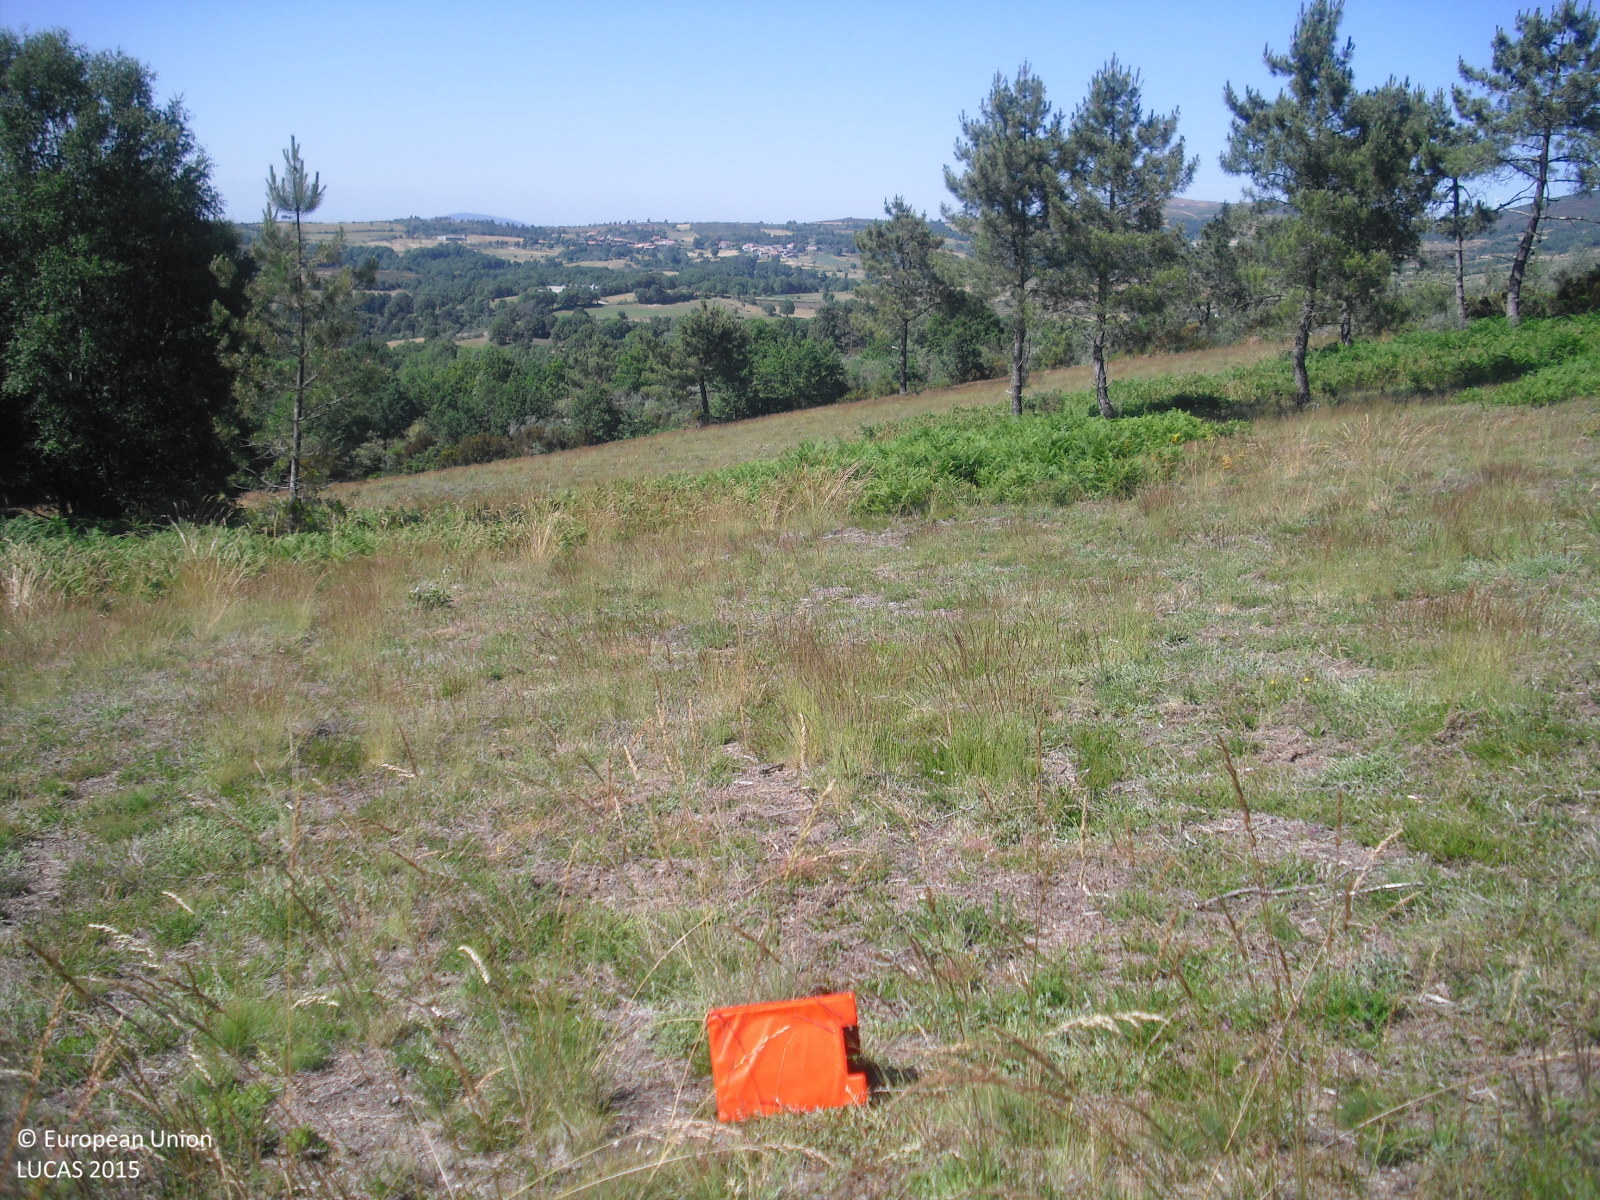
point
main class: Shrubland
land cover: Shrubland without tree cover
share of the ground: > 75 %
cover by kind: shrubs 70 %, herbaceous plants 30 %
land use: Semi-natural and natural areas not in use
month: June
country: ES
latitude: 42.5878
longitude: -7.9344
